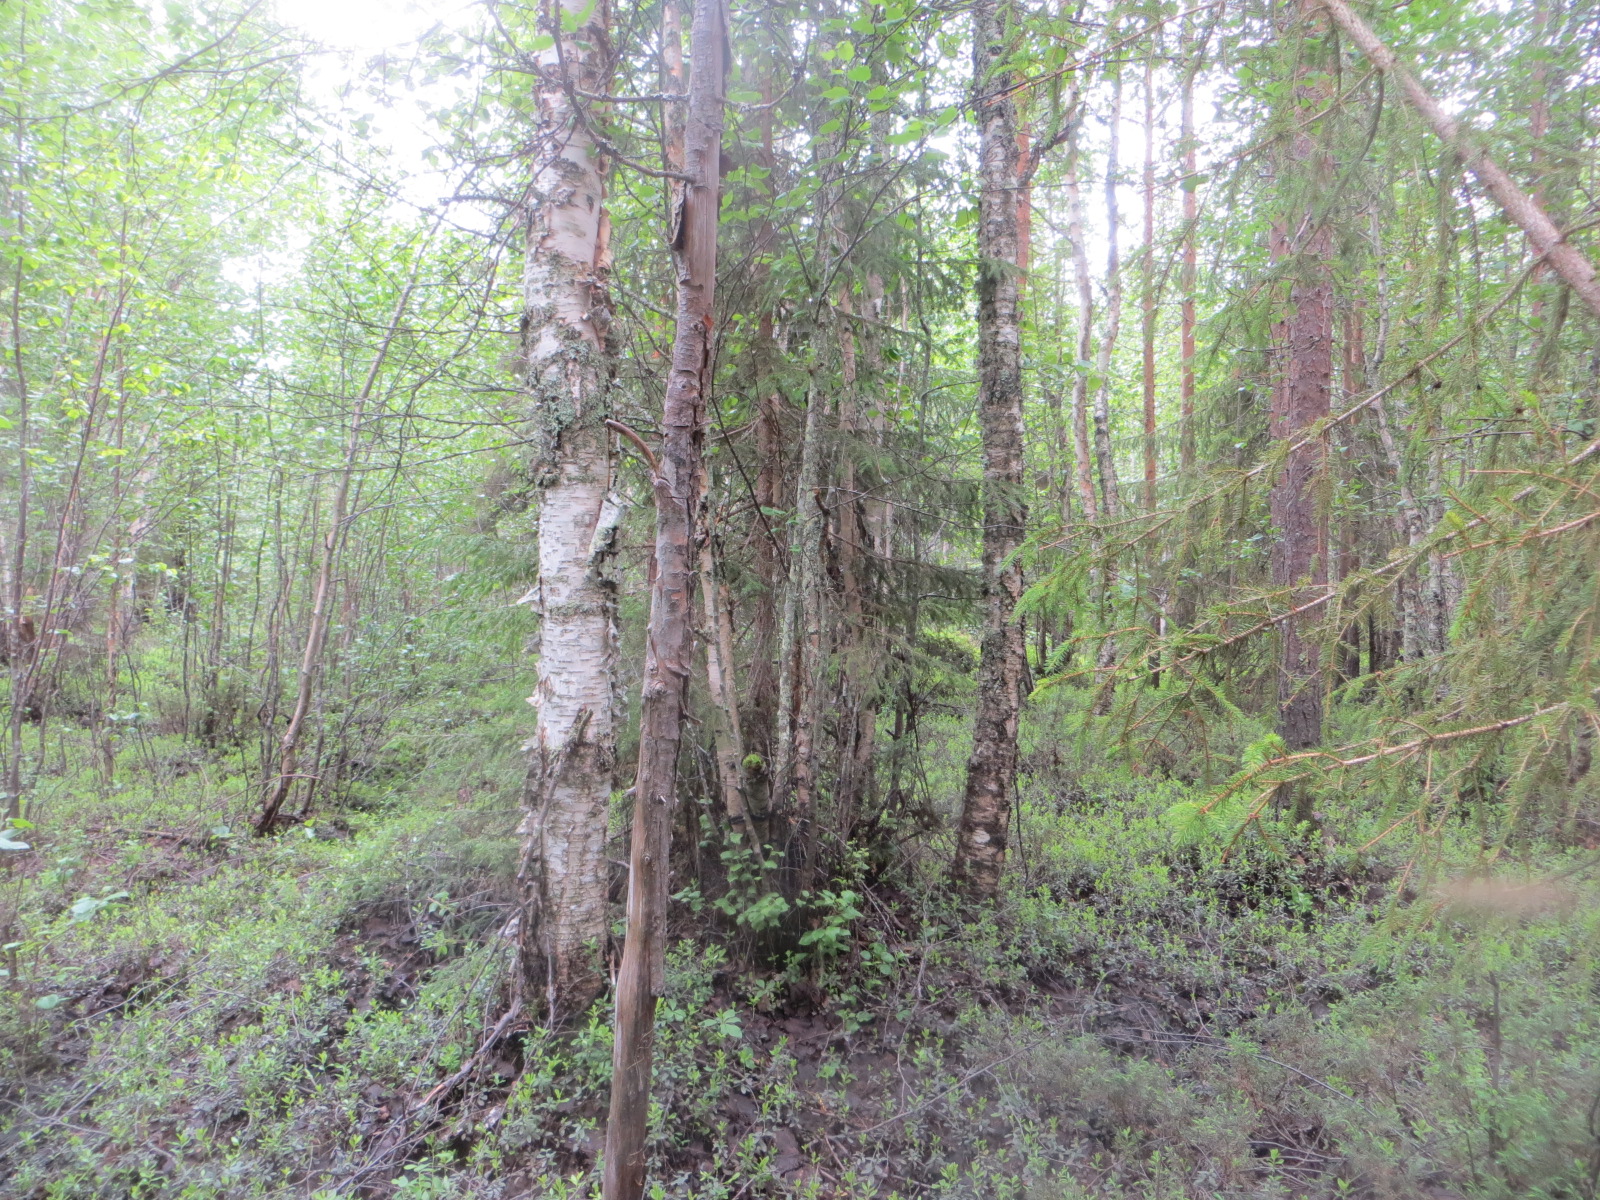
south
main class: Woodland
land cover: Pine dominated mixed woodland
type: boreal forest
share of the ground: > 75 %
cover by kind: broadleaved forest trees 40 %, coniferous forest trees 35 %, shrubs 25 %
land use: Forestry
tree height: > 5 m
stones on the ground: < 10 %
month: July
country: FI
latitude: 66.4723
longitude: 24.3423
